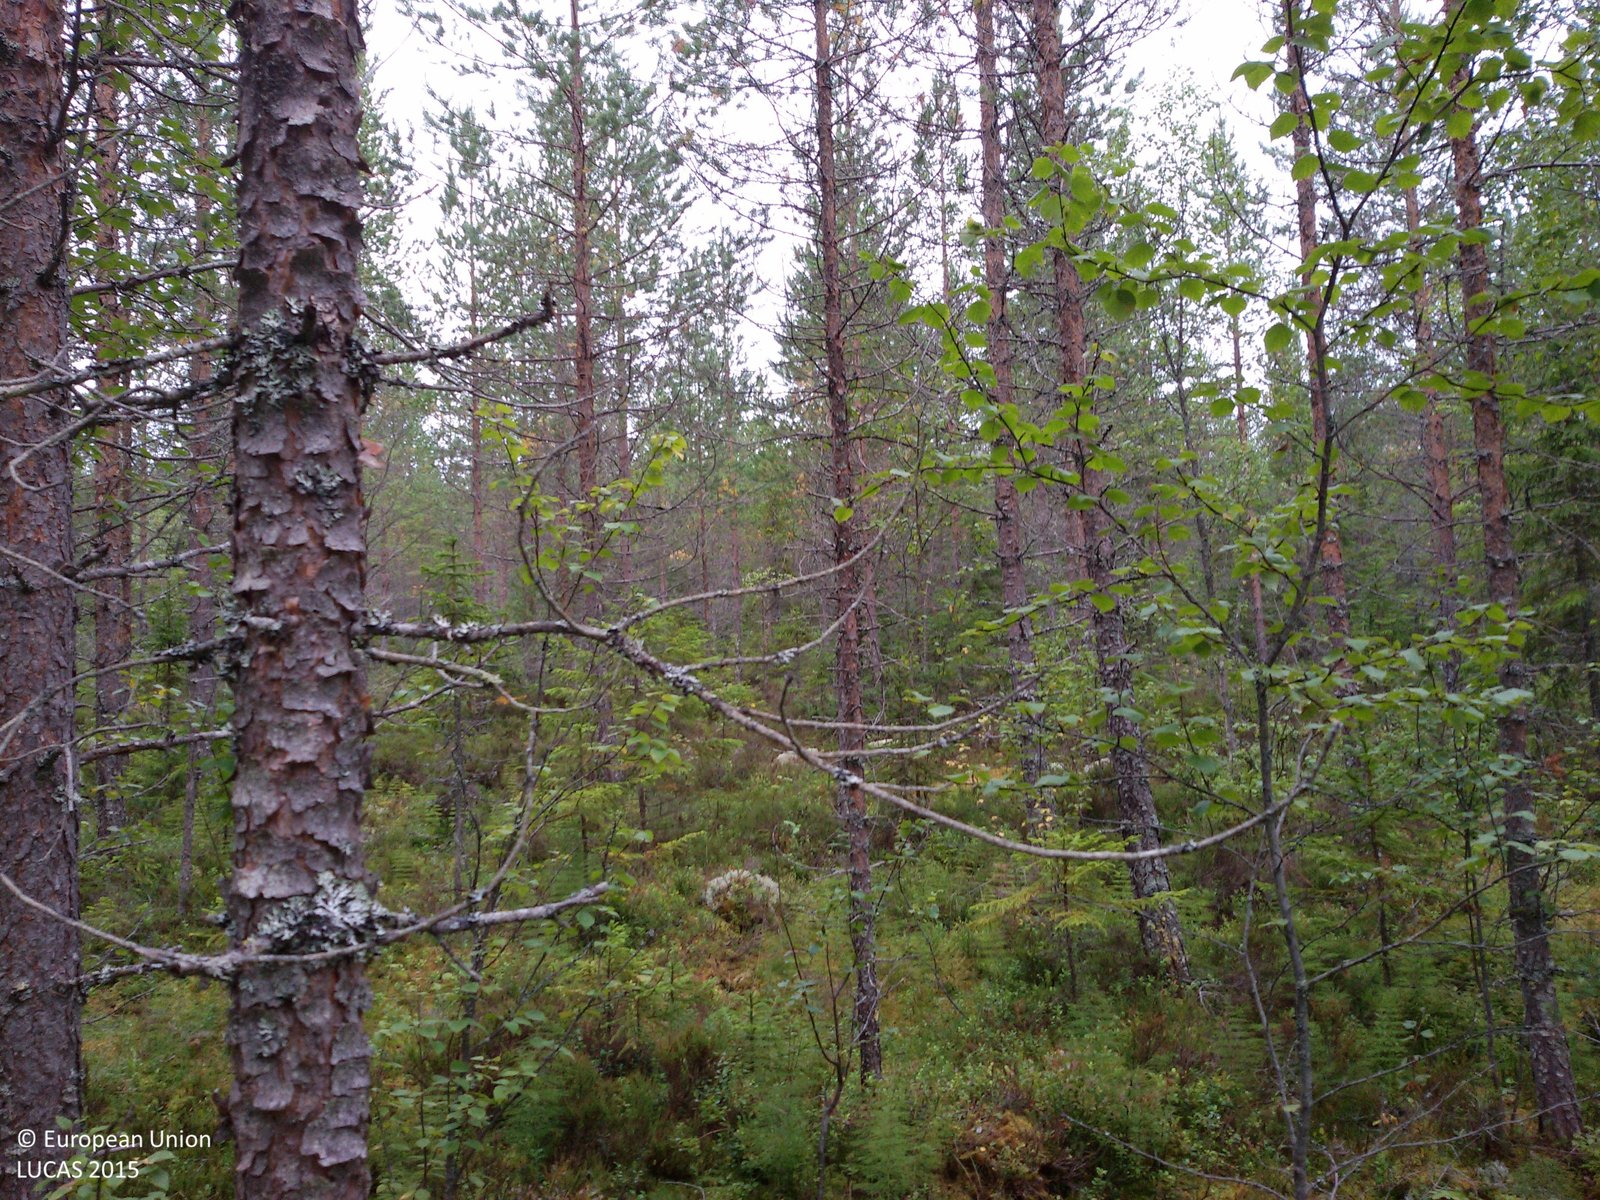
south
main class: Woodland
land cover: Pine dominated coniferous woodland
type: boreal forest
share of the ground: 50 - 75 %
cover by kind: coniferous forest trees 70 %, lichens and mosses 15 %, herbaceous plants 10 %, broadleaved forest trees 5 %
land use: Forestry
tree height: > 5 m
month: August
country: SE
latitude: 60.9537
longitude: 16.0608
